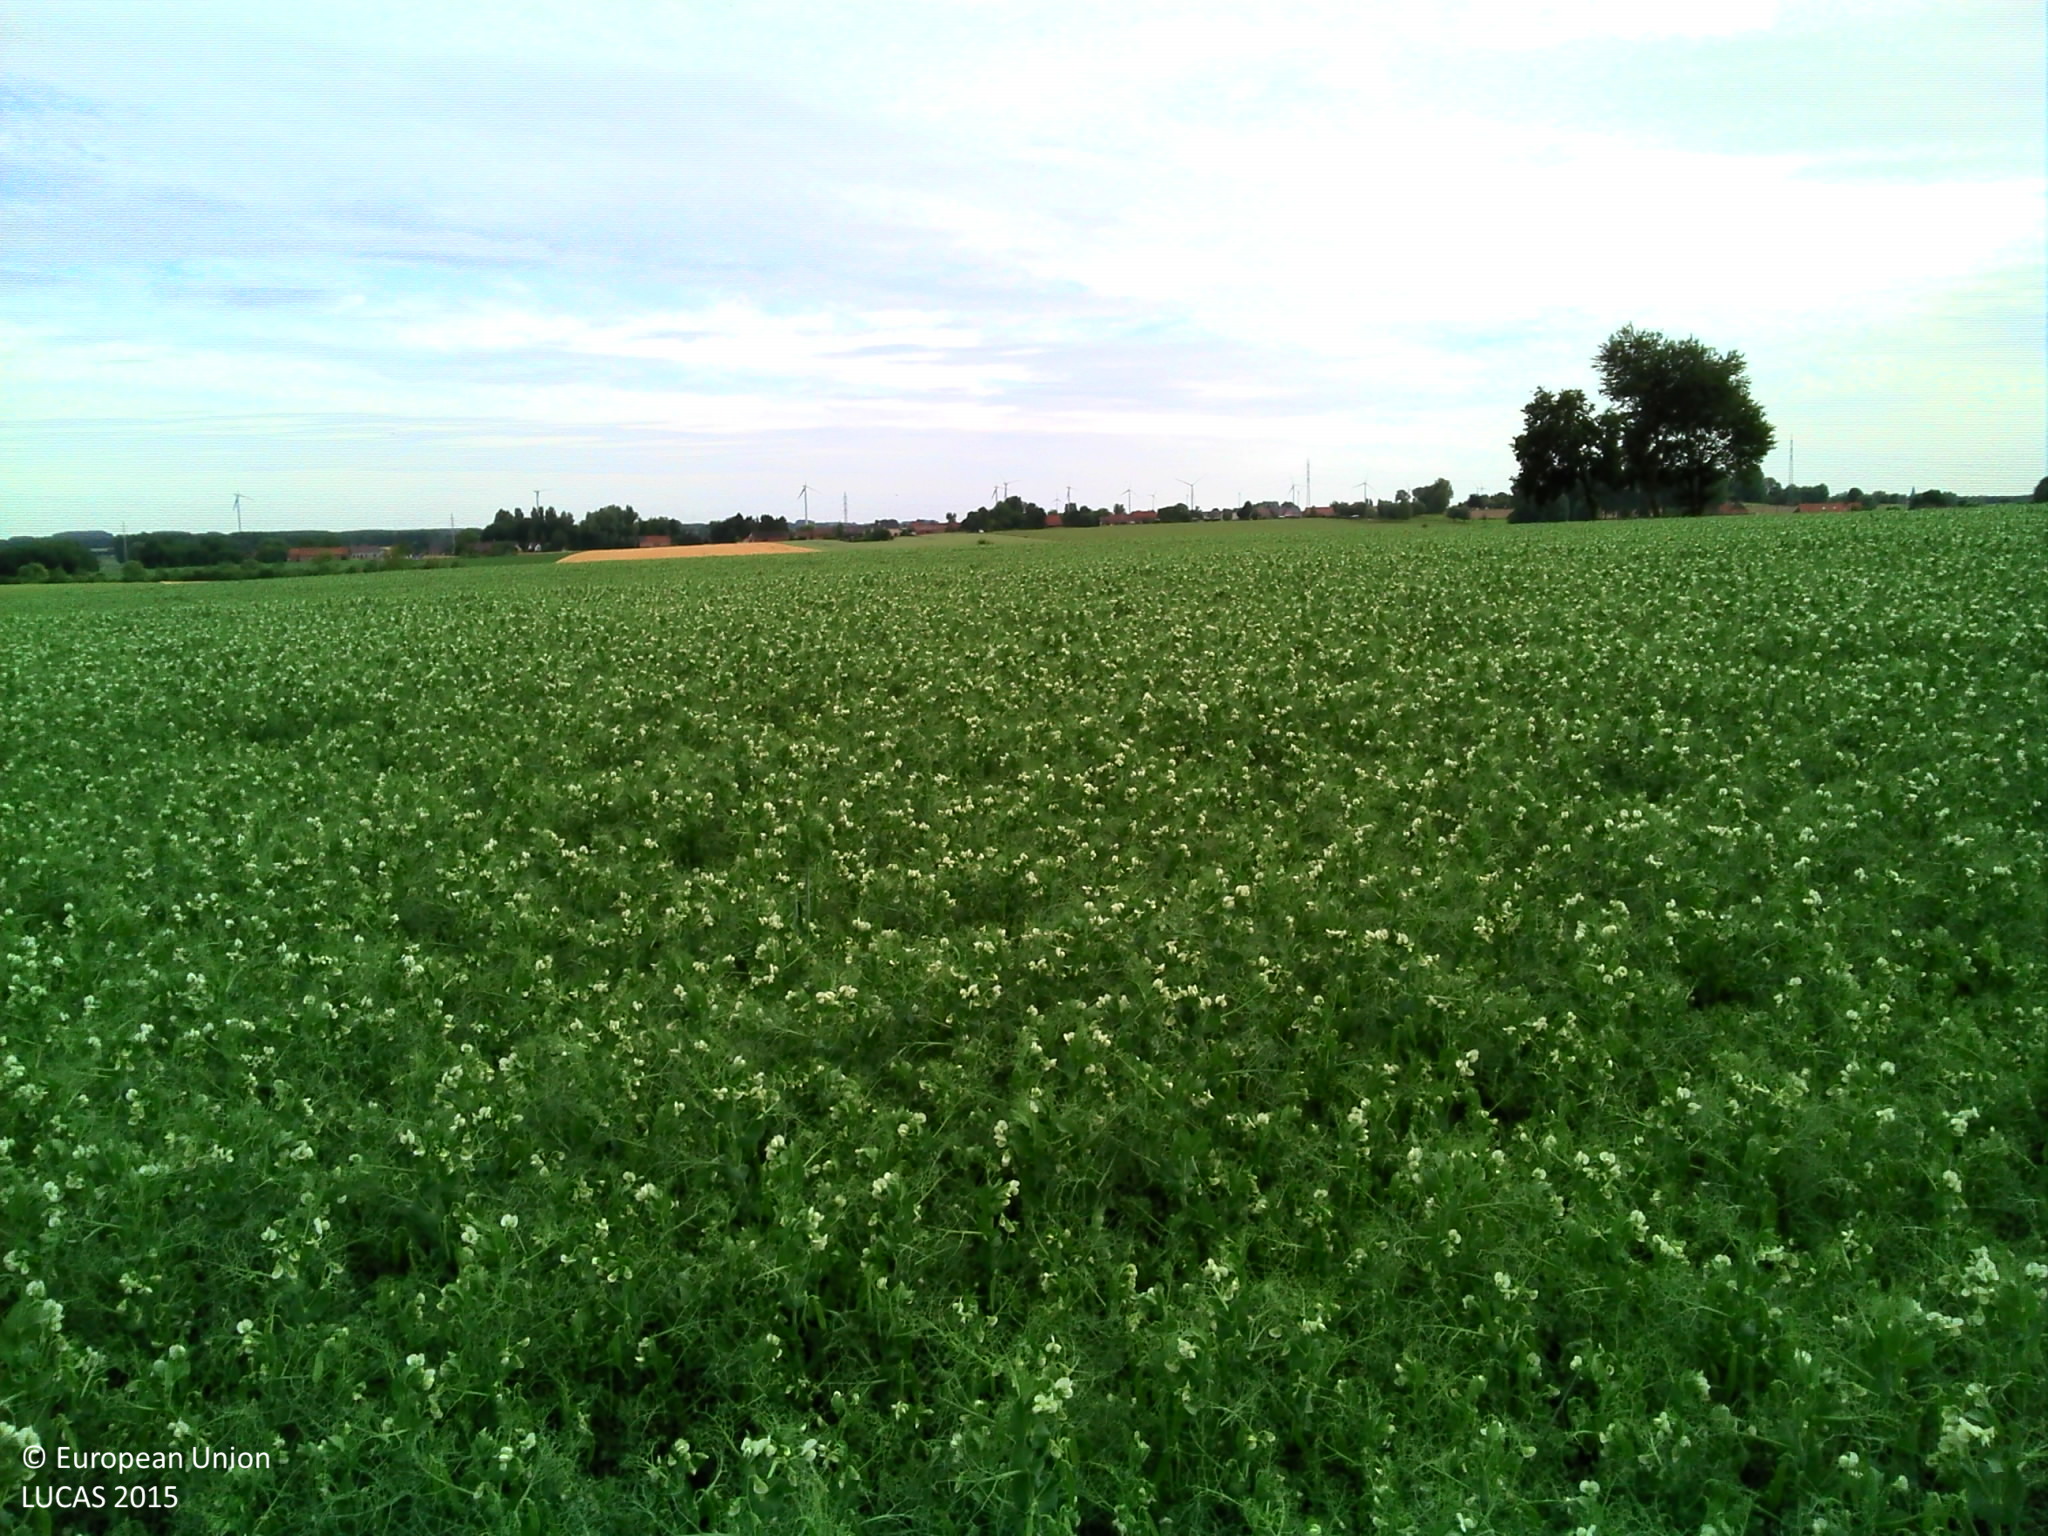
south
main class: Cropland
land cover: Dry pulses
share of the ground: > 75 %
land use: Agriculture (excluding fallow land and kitchen gardens)
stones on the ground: < 10 %
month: June
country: BE
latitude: 50.6382
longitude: 3.6441
